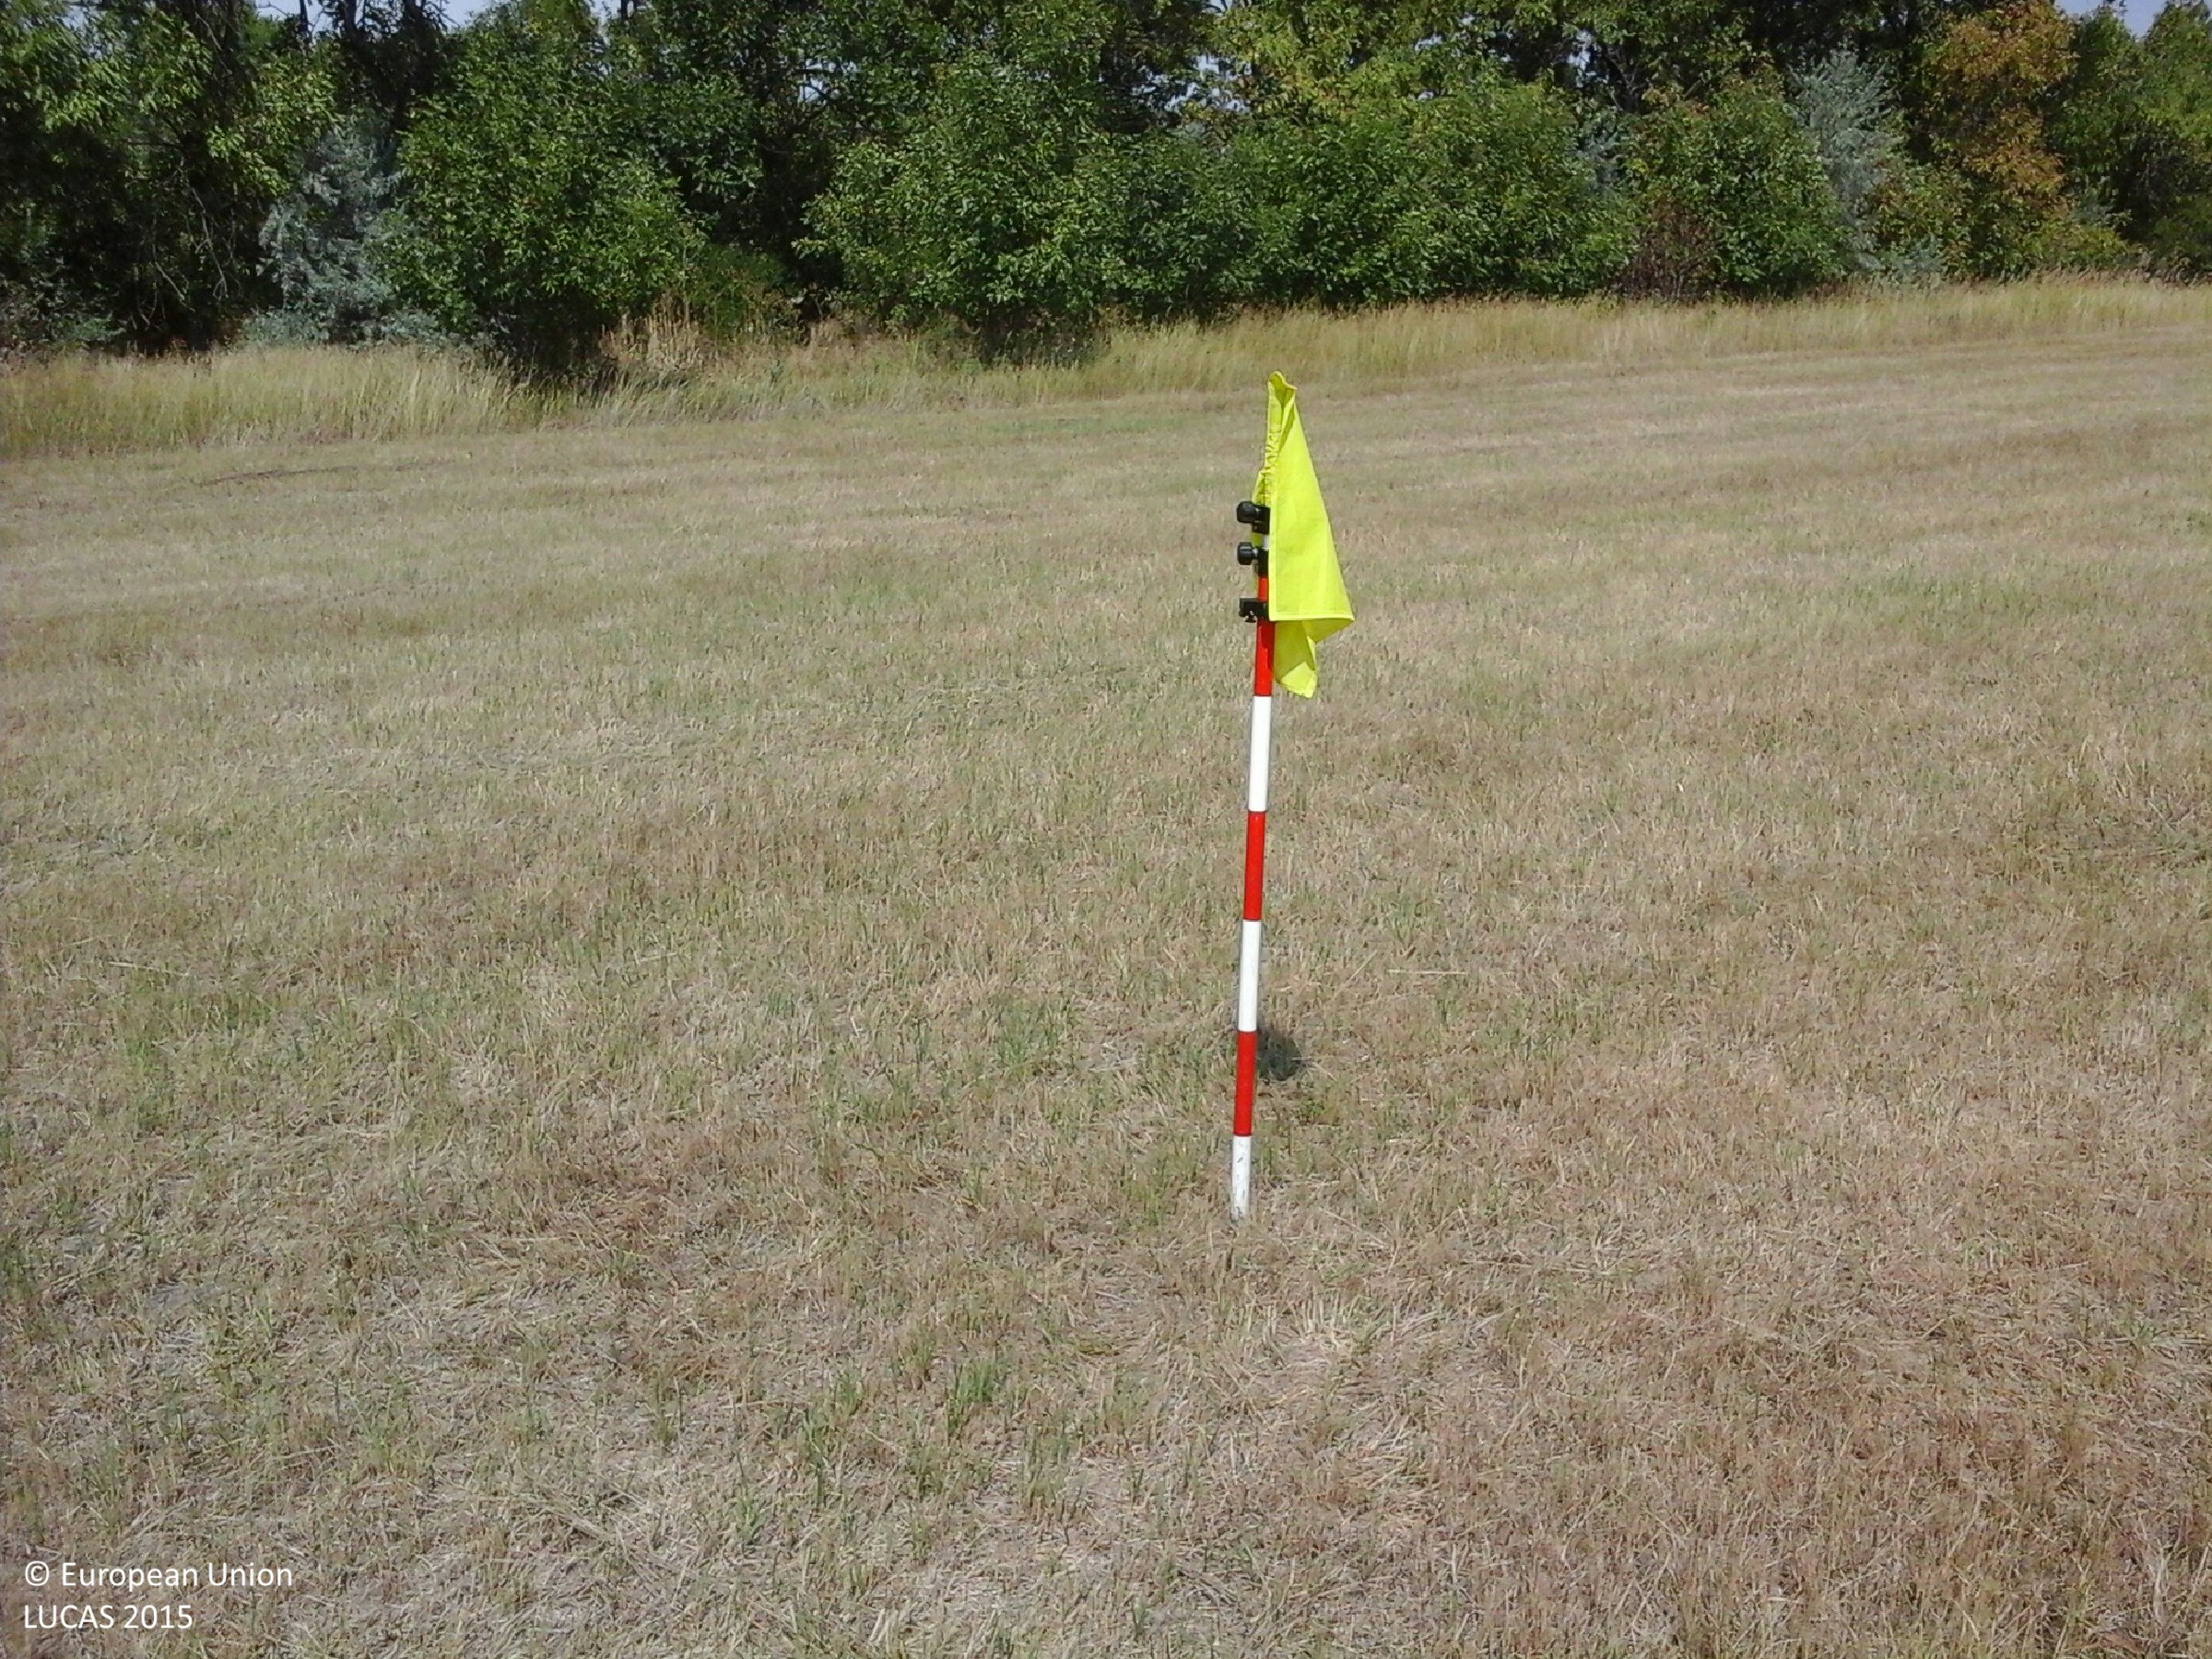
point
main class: Grassland
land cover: Grassland without tree/shrub cover
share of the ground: > 75 %
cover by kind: herbaceous plants 100 %
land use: Agriculture (excluding fallow land and kitchen gardens)
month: July
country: HU
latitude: 47.4566
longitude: 20.6036
